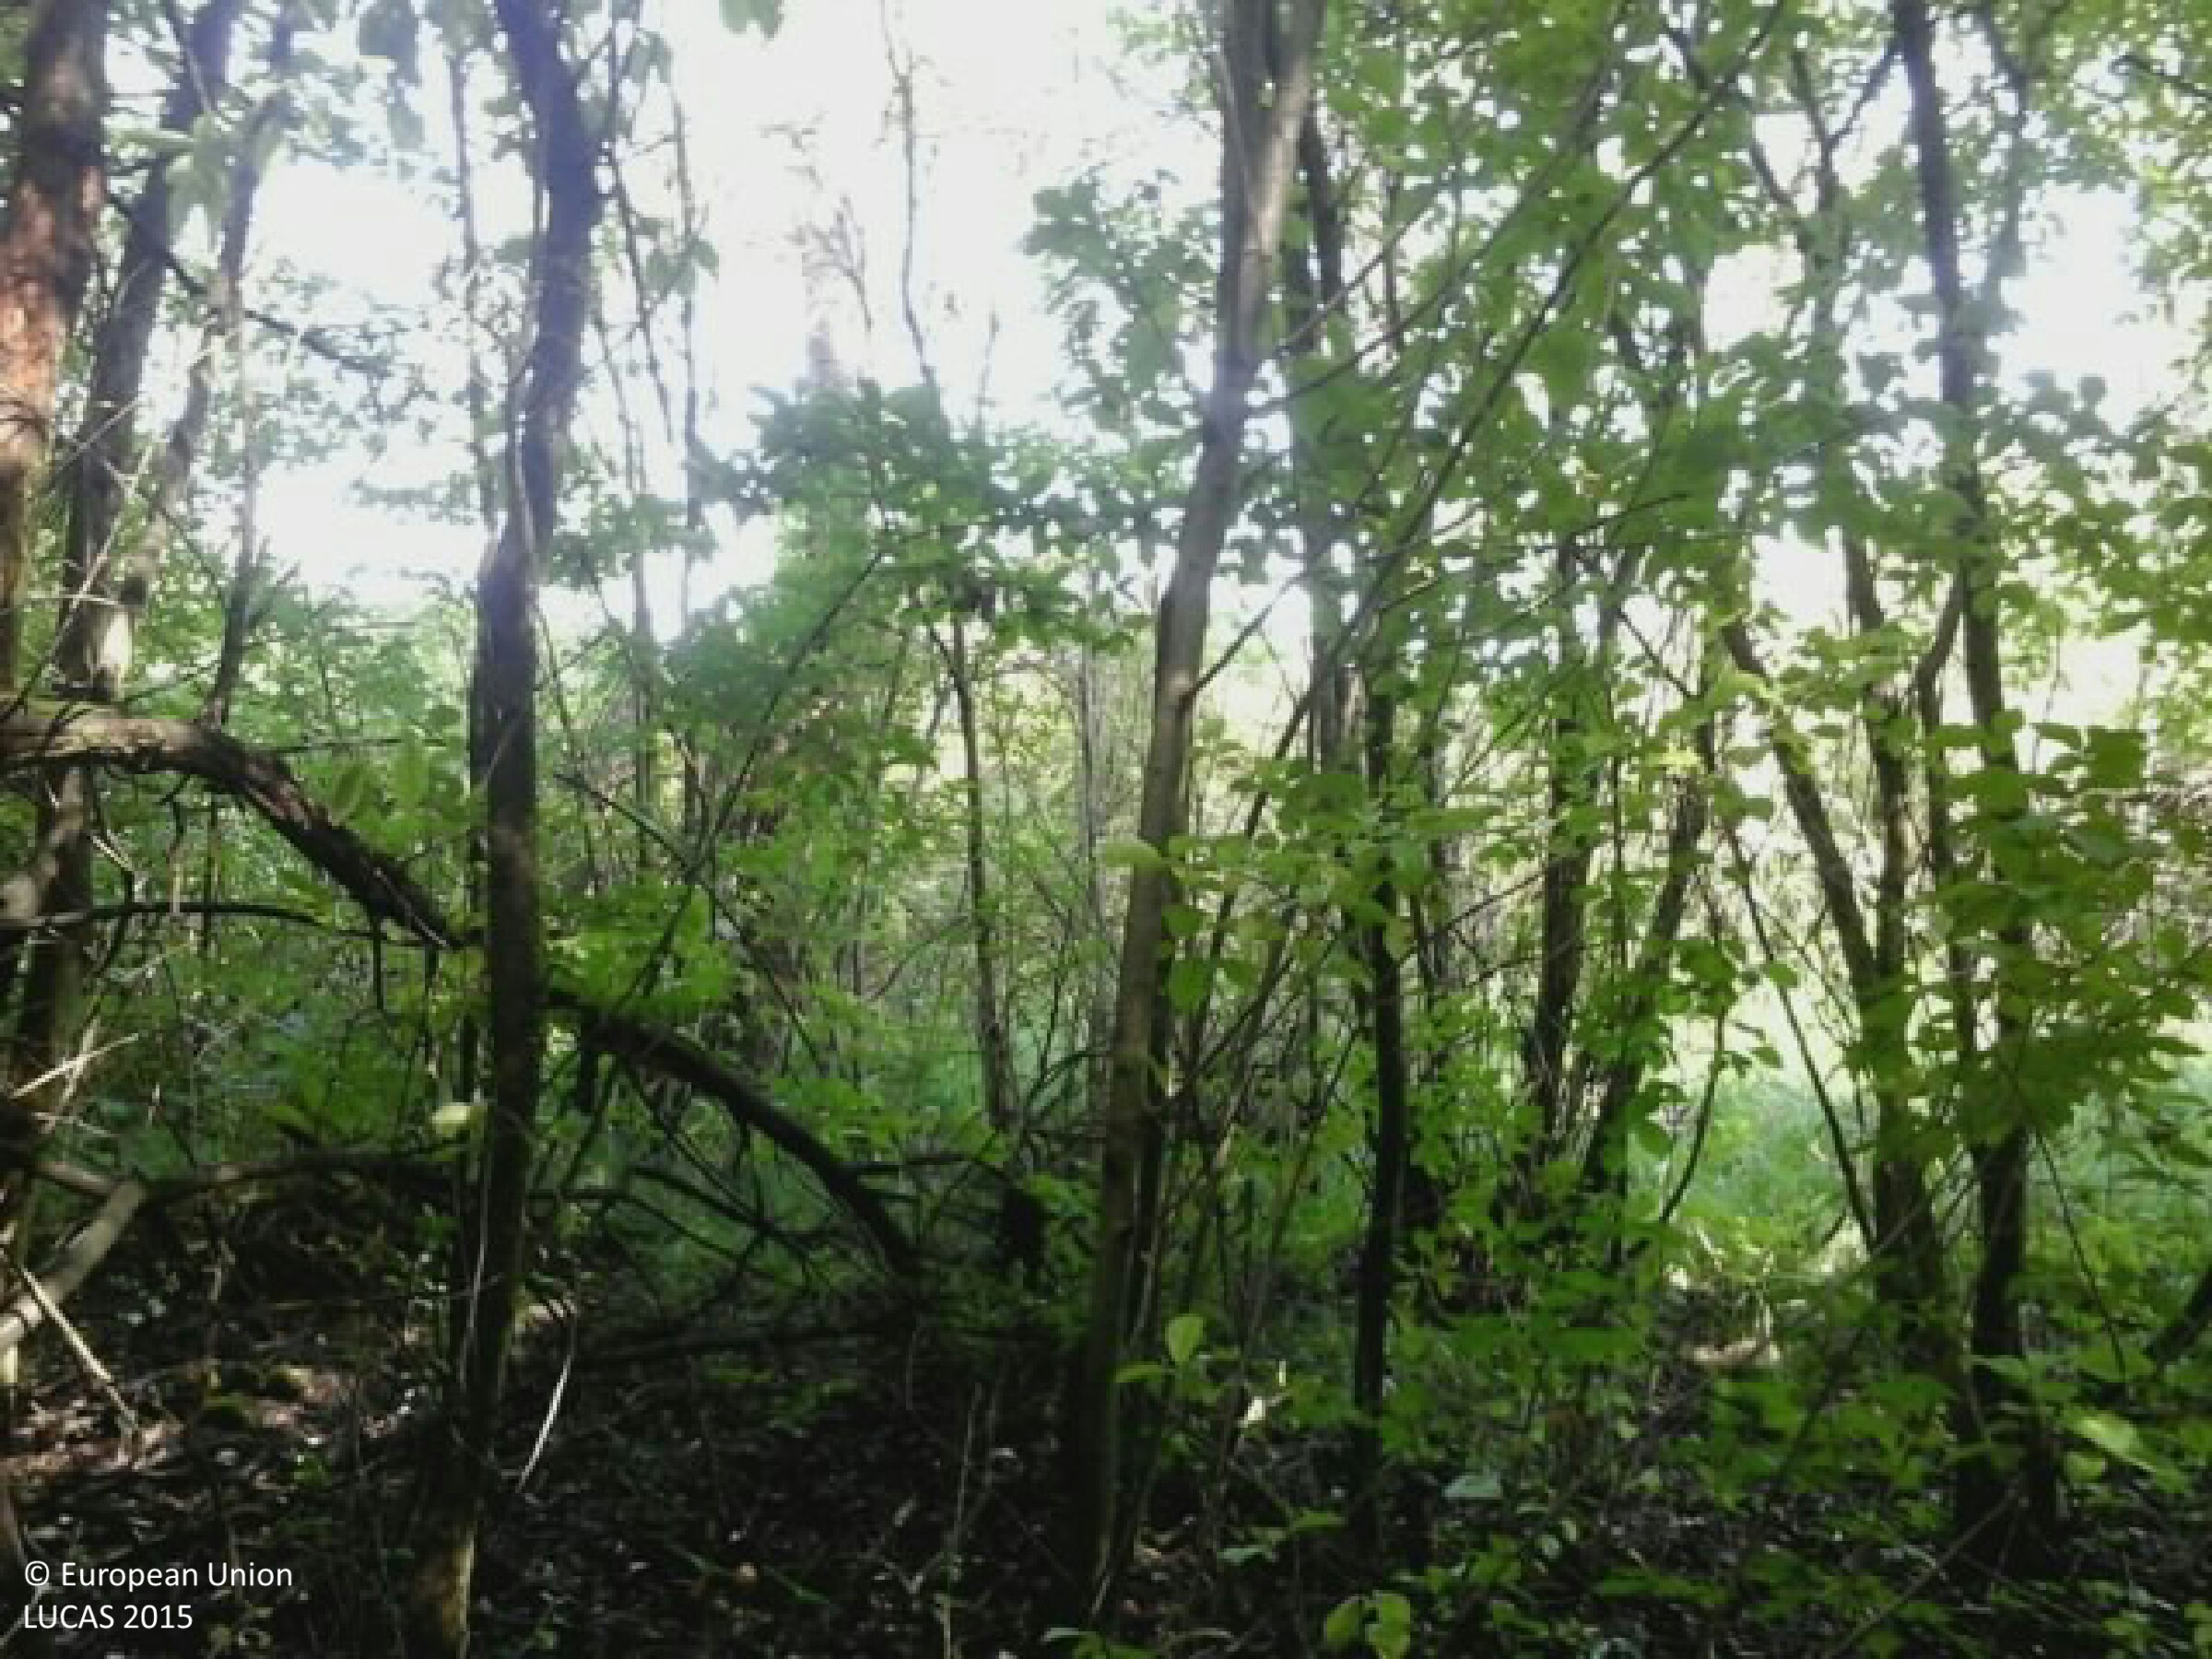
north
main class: Woodland
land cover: Broadleaved woodland
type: mesophytic deciduous forest
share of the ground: > 75 %
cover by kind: broadleaved forest trees 85 %, shrubs 10 %, herbaceous plants 5 %
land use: Forestry
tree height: > 5 m
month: August
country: HU
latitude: 47.1613
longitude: 19.6906
